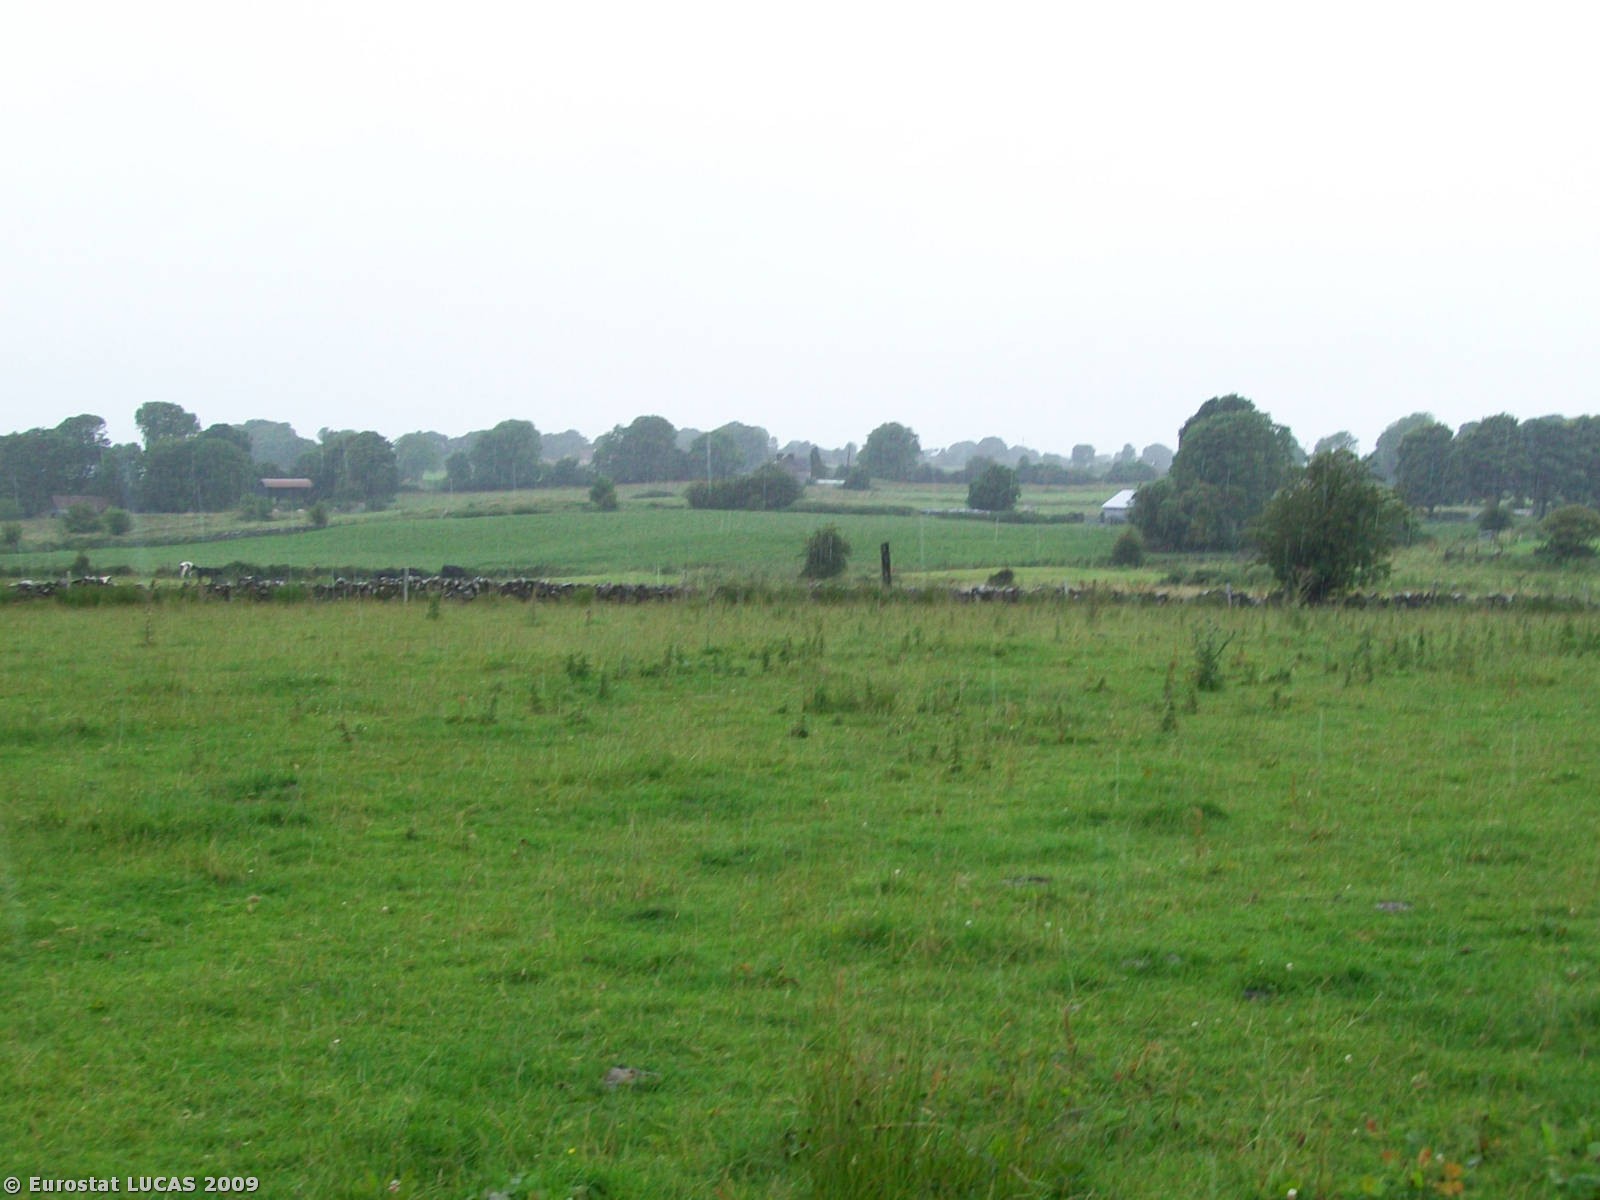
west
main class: Grassland
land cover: Grassland without tree/shrub cover
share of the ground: > 75 %
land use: Agriculture (excluding fallow land and kitchen gardens)
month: July
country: IE
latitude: 53.6255
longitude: -8.9439
